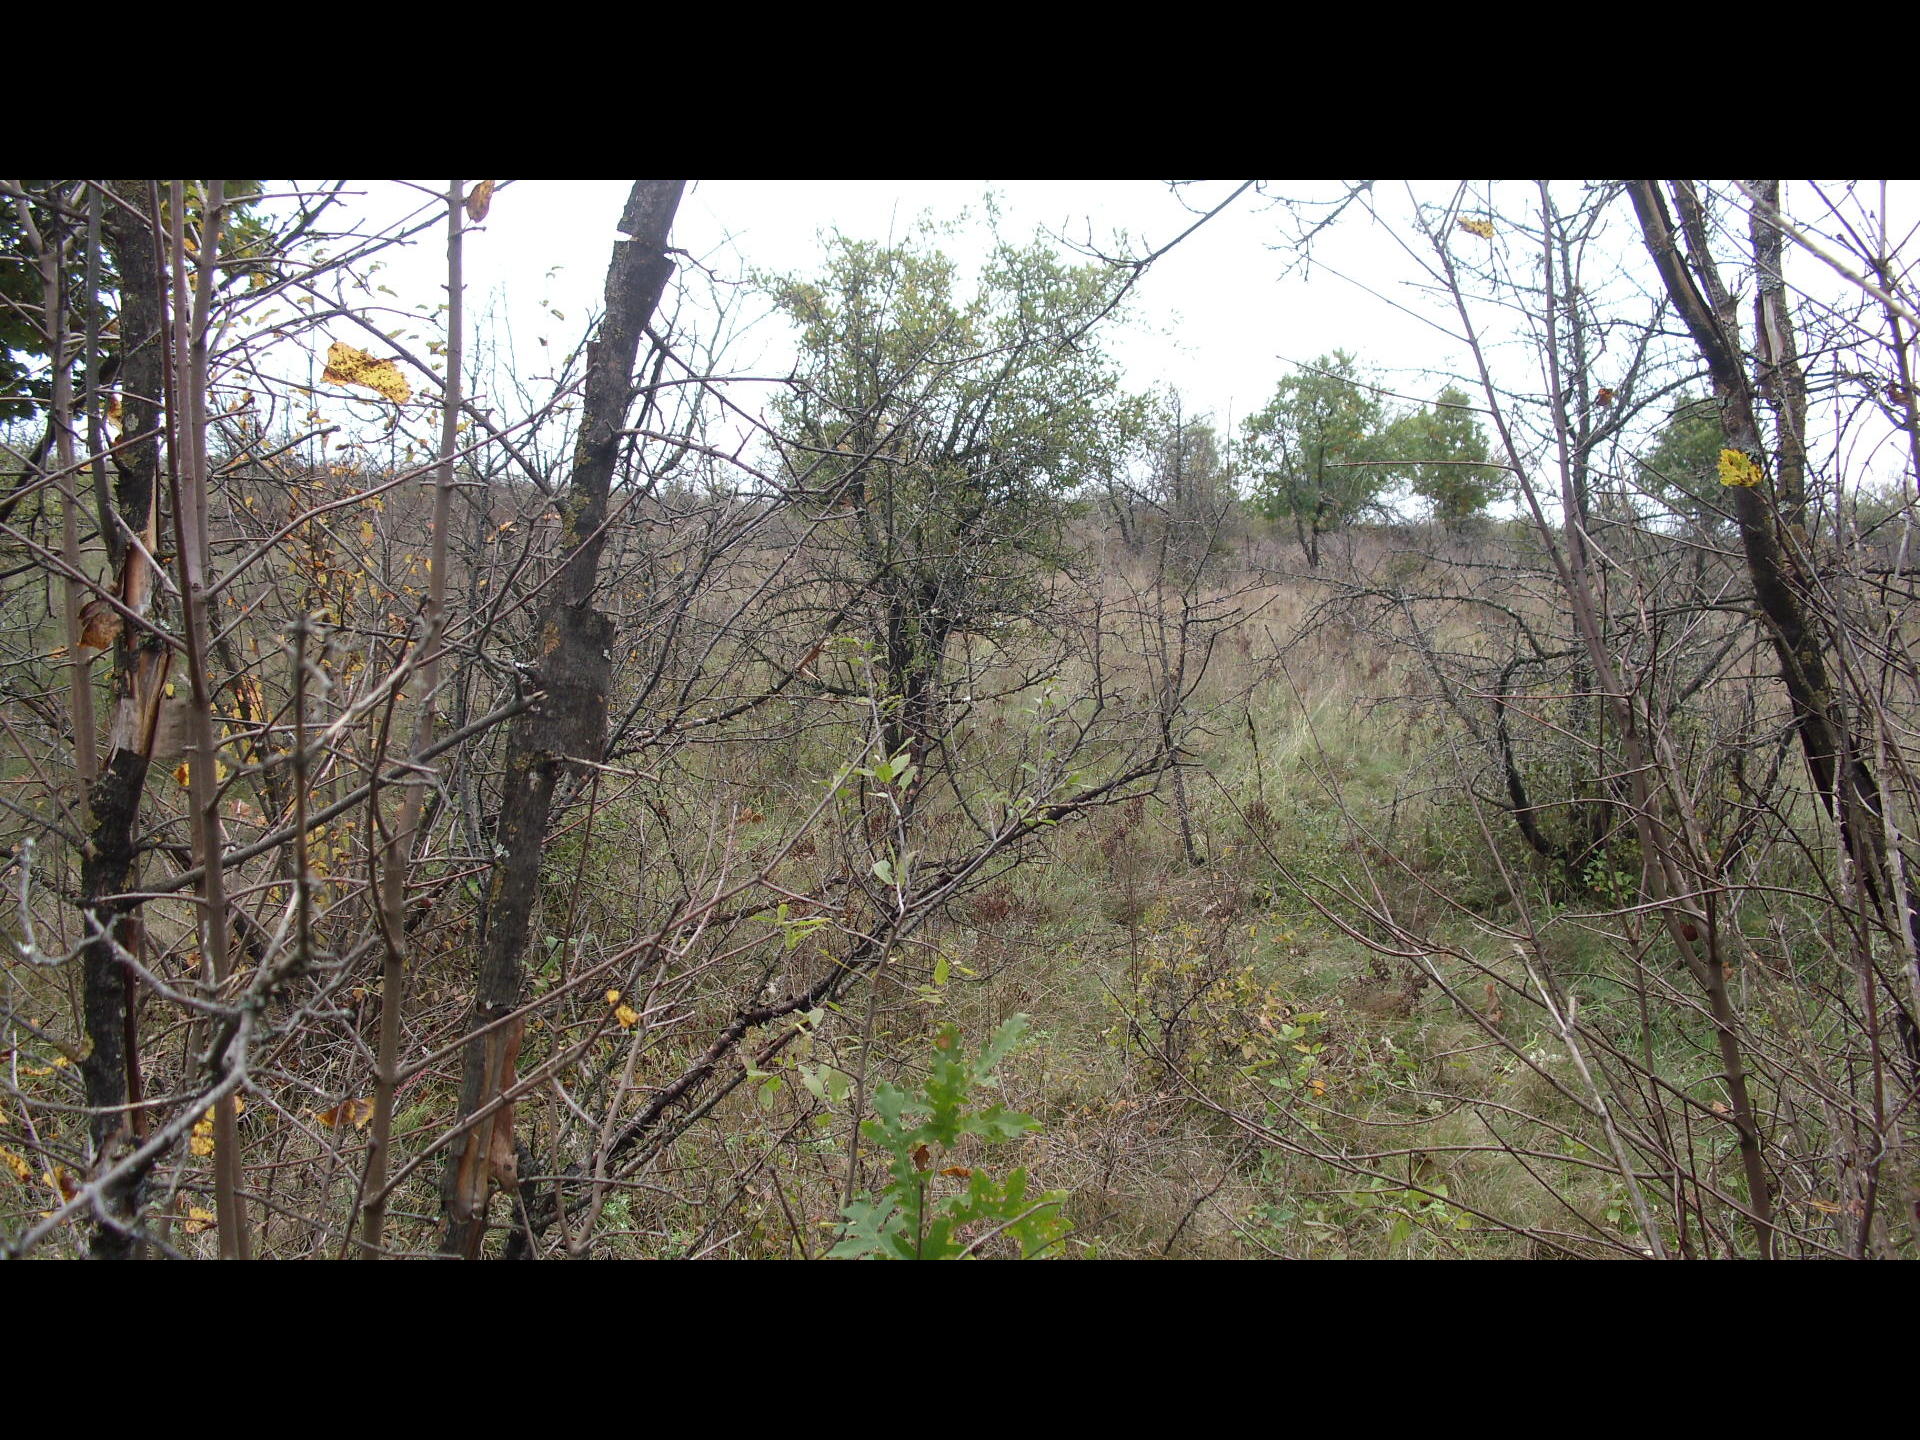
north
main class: Shrubland
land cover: Shrubland with sparse tree cover
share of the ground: > 75 %
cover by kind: shrubs 85 %, herbaceous plants 10 %, broadleaved forest trees 5 %
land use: Semi-natural and natural areas not in use
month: October
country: BG
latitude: 43.6707
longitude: 22.5968
